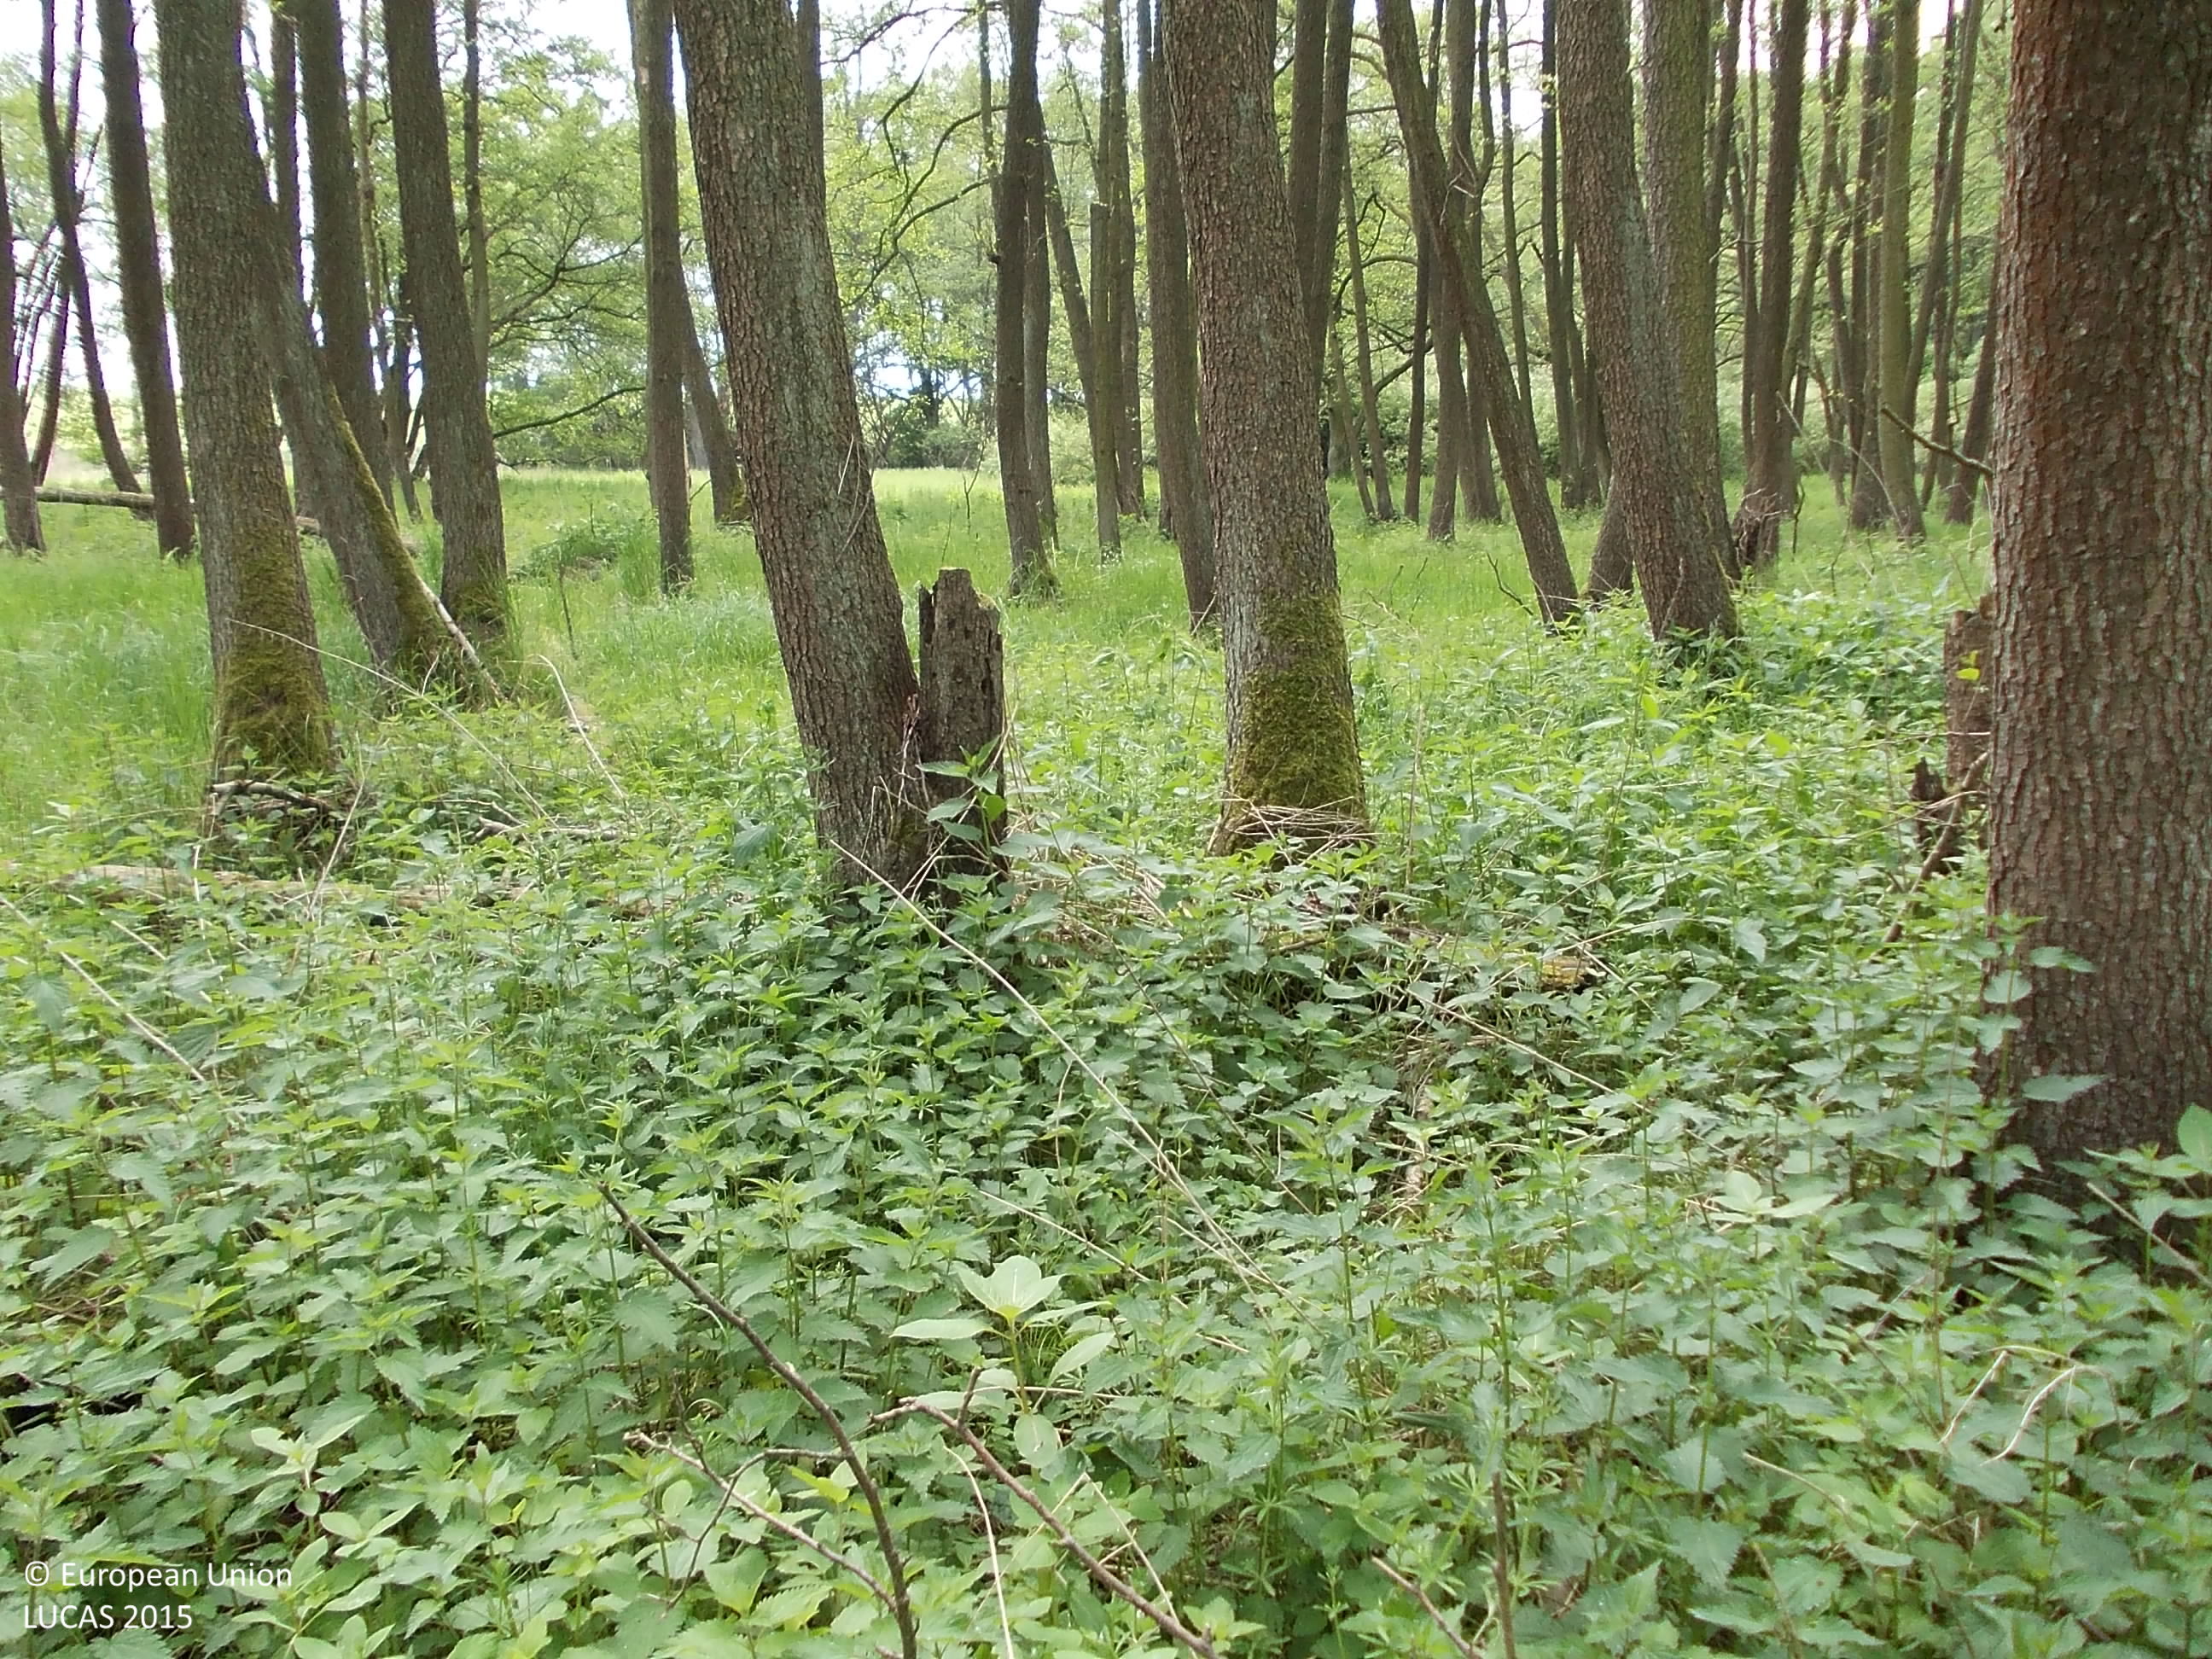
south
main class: Woodland
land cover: Broadleaved woodland
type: mire and swamp forests
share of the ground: > 75 %
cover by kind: broadleaved forest trees 80 %, herbaceous plants 20 %
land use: Semi-natural and natural areas not in use
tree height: > 5 m
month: May
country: CZ
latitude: 49.4370
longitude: 13.7927
